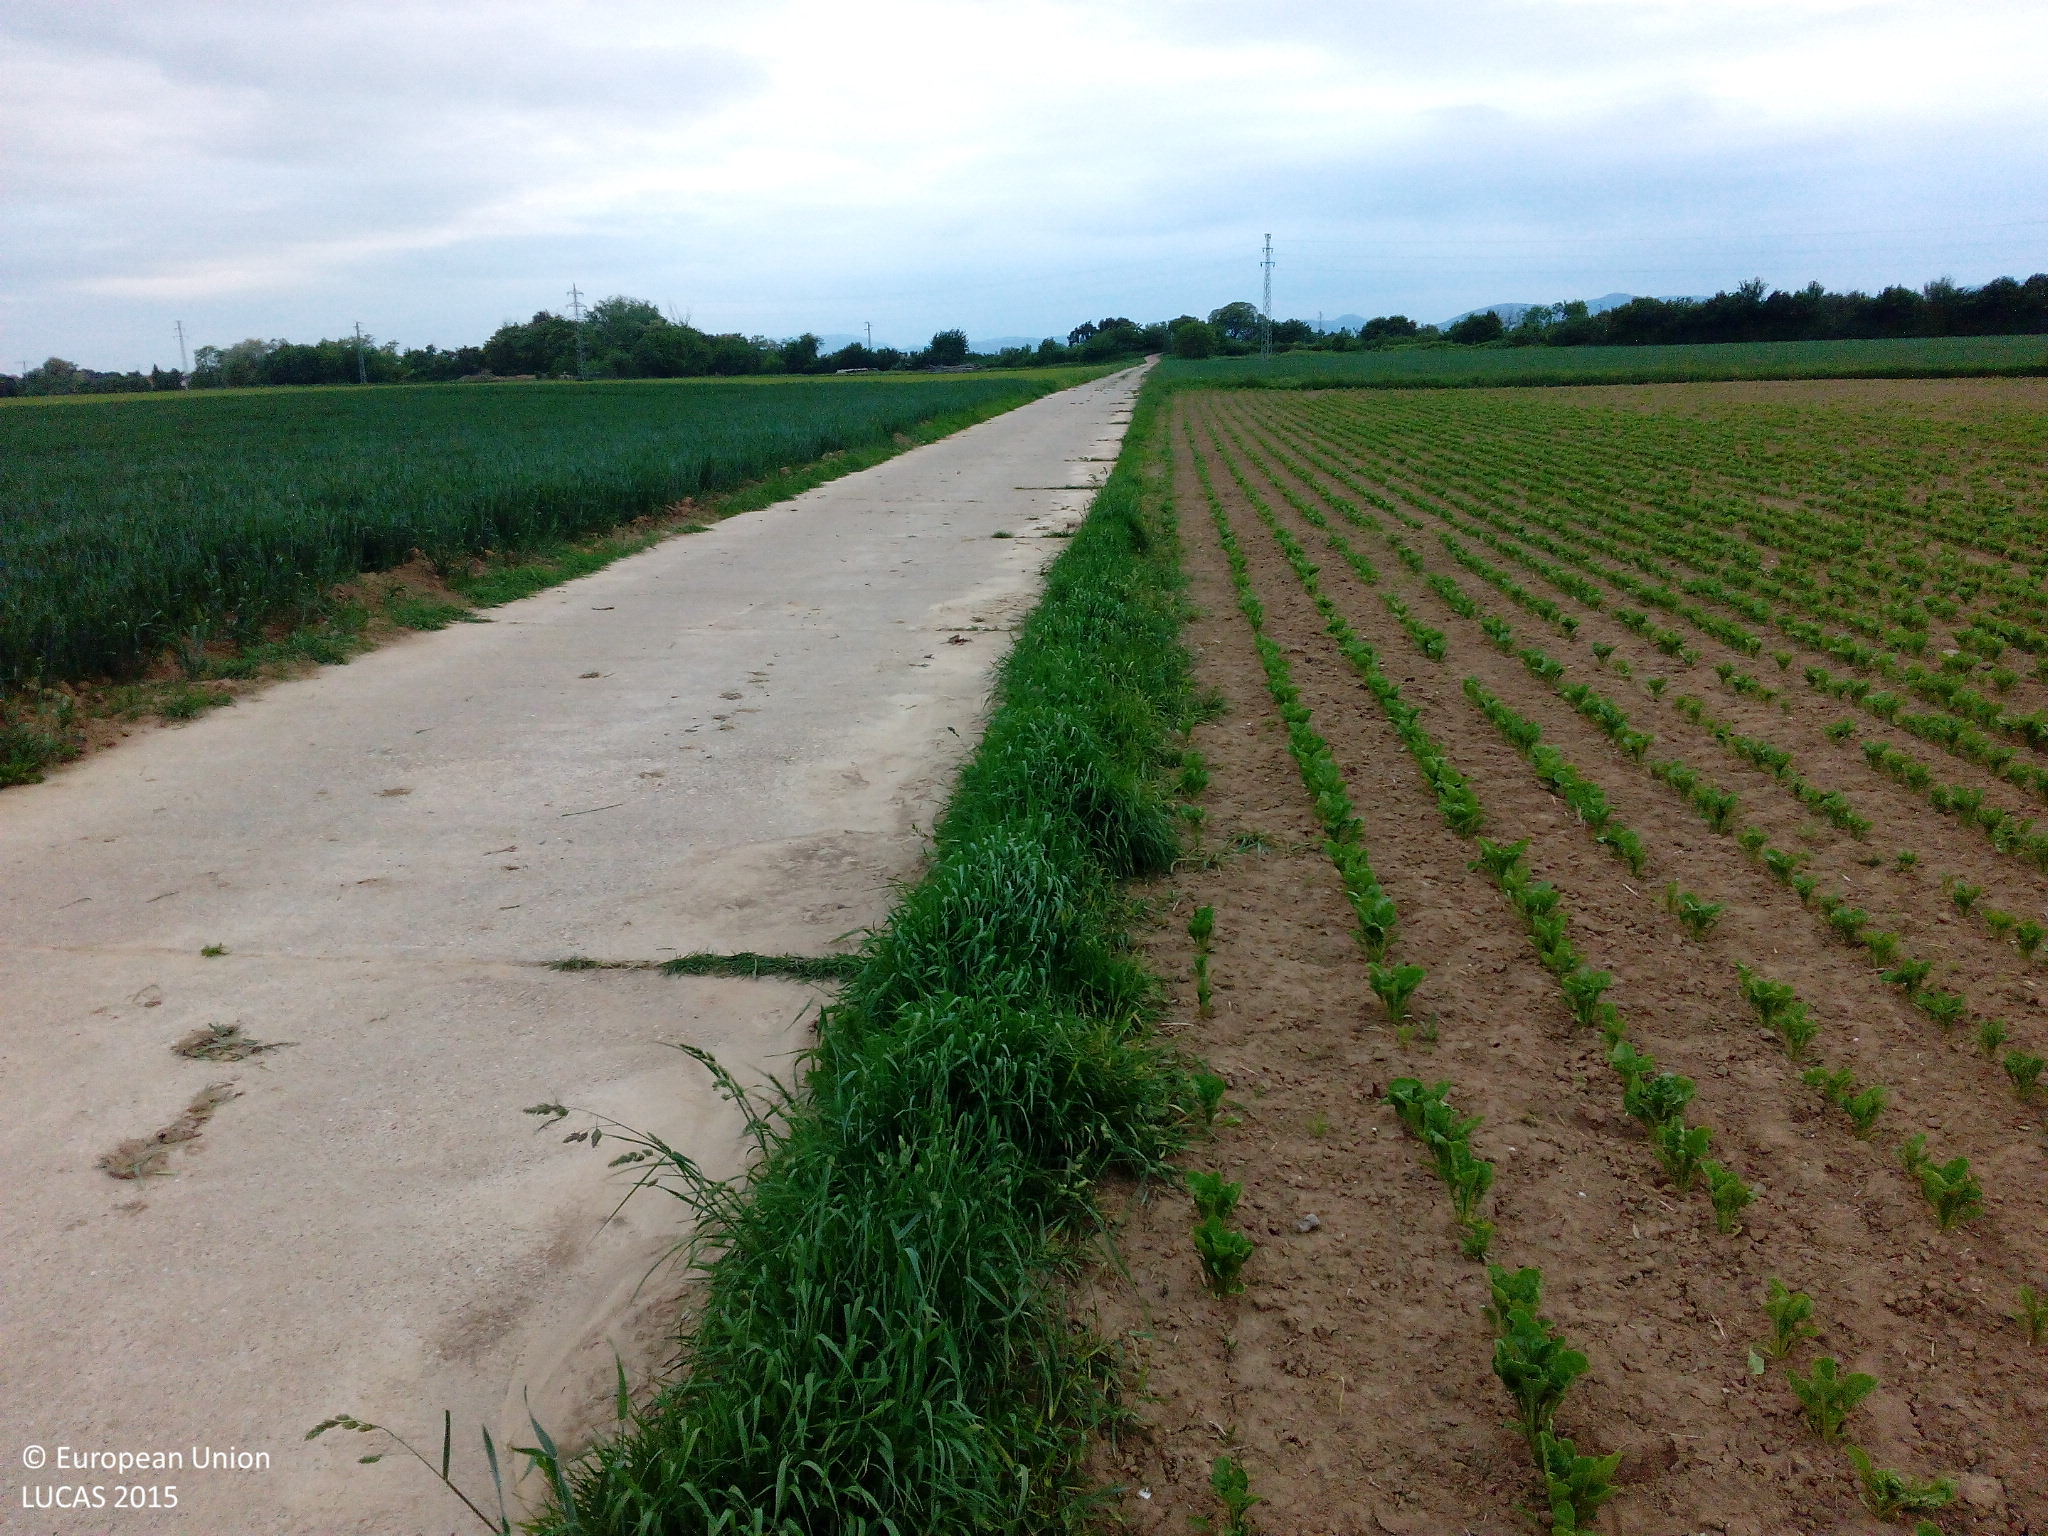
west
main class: Cropland
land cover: Sugar beet
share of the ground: < 10 %
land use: Agriculture (excluding fallow land and kitchen gardens)
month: May
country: DE
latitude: 49.1438
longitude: 8.1499
